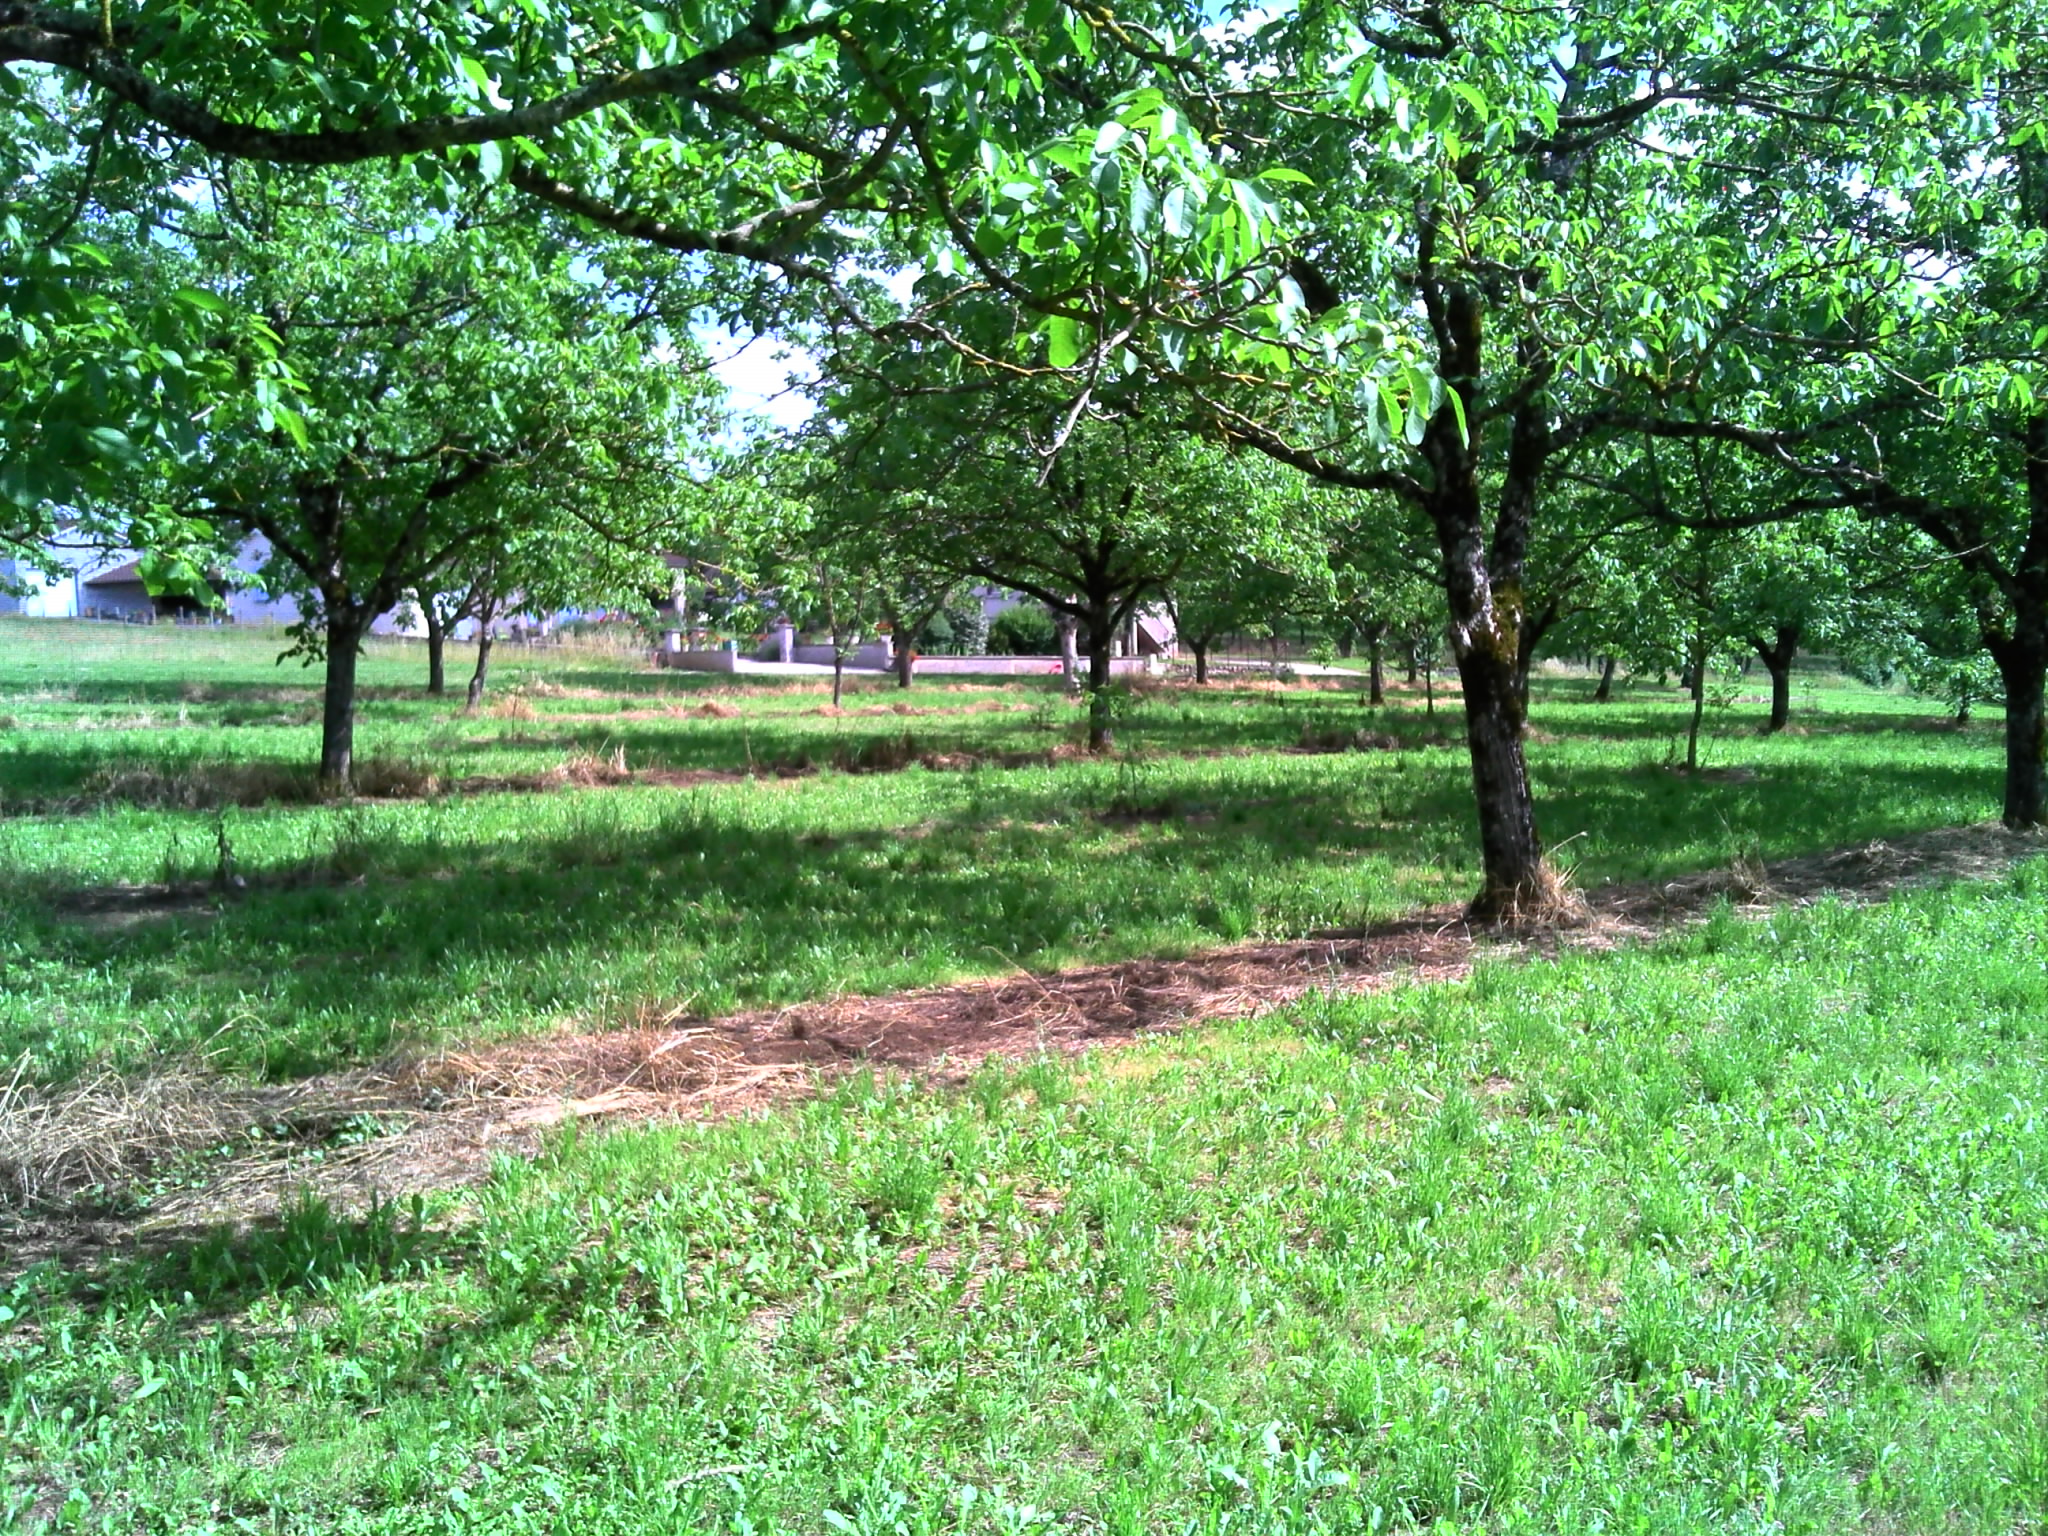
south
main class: Cropland
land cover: Nuts trees
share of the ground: > 75 %
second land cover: Grassland without tree/shrub cover
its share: 10 - 25 %
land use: Agriculture (excluding fallow land and kitchen gardens)
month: June
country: FR
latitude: 44.9195
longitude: 1.8778
